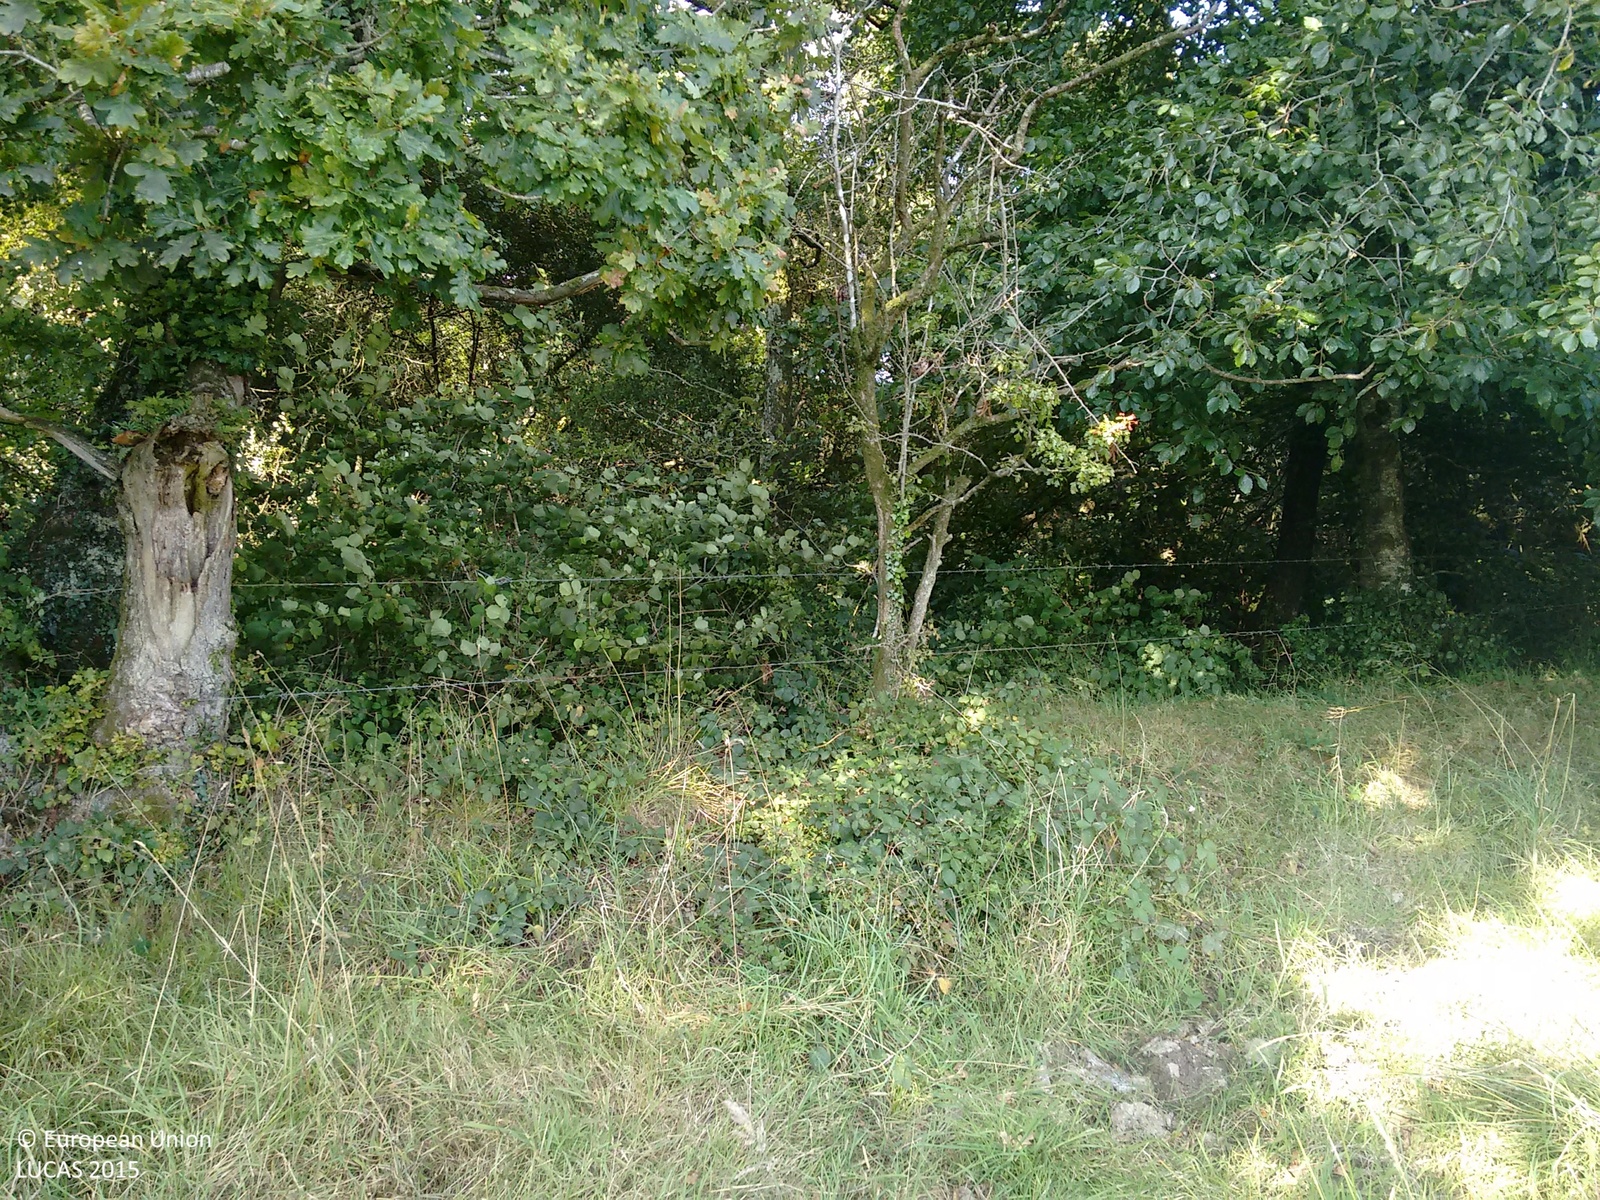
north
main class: Grassland
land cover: Grassland without tree/shrub cover
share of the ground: > 75 %
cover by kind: herbaceous plants 100 %
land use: Agriculture (excluding fallow land and kitchen gardens)
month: September
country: GB
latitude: 50.8667
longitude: -4.2951
